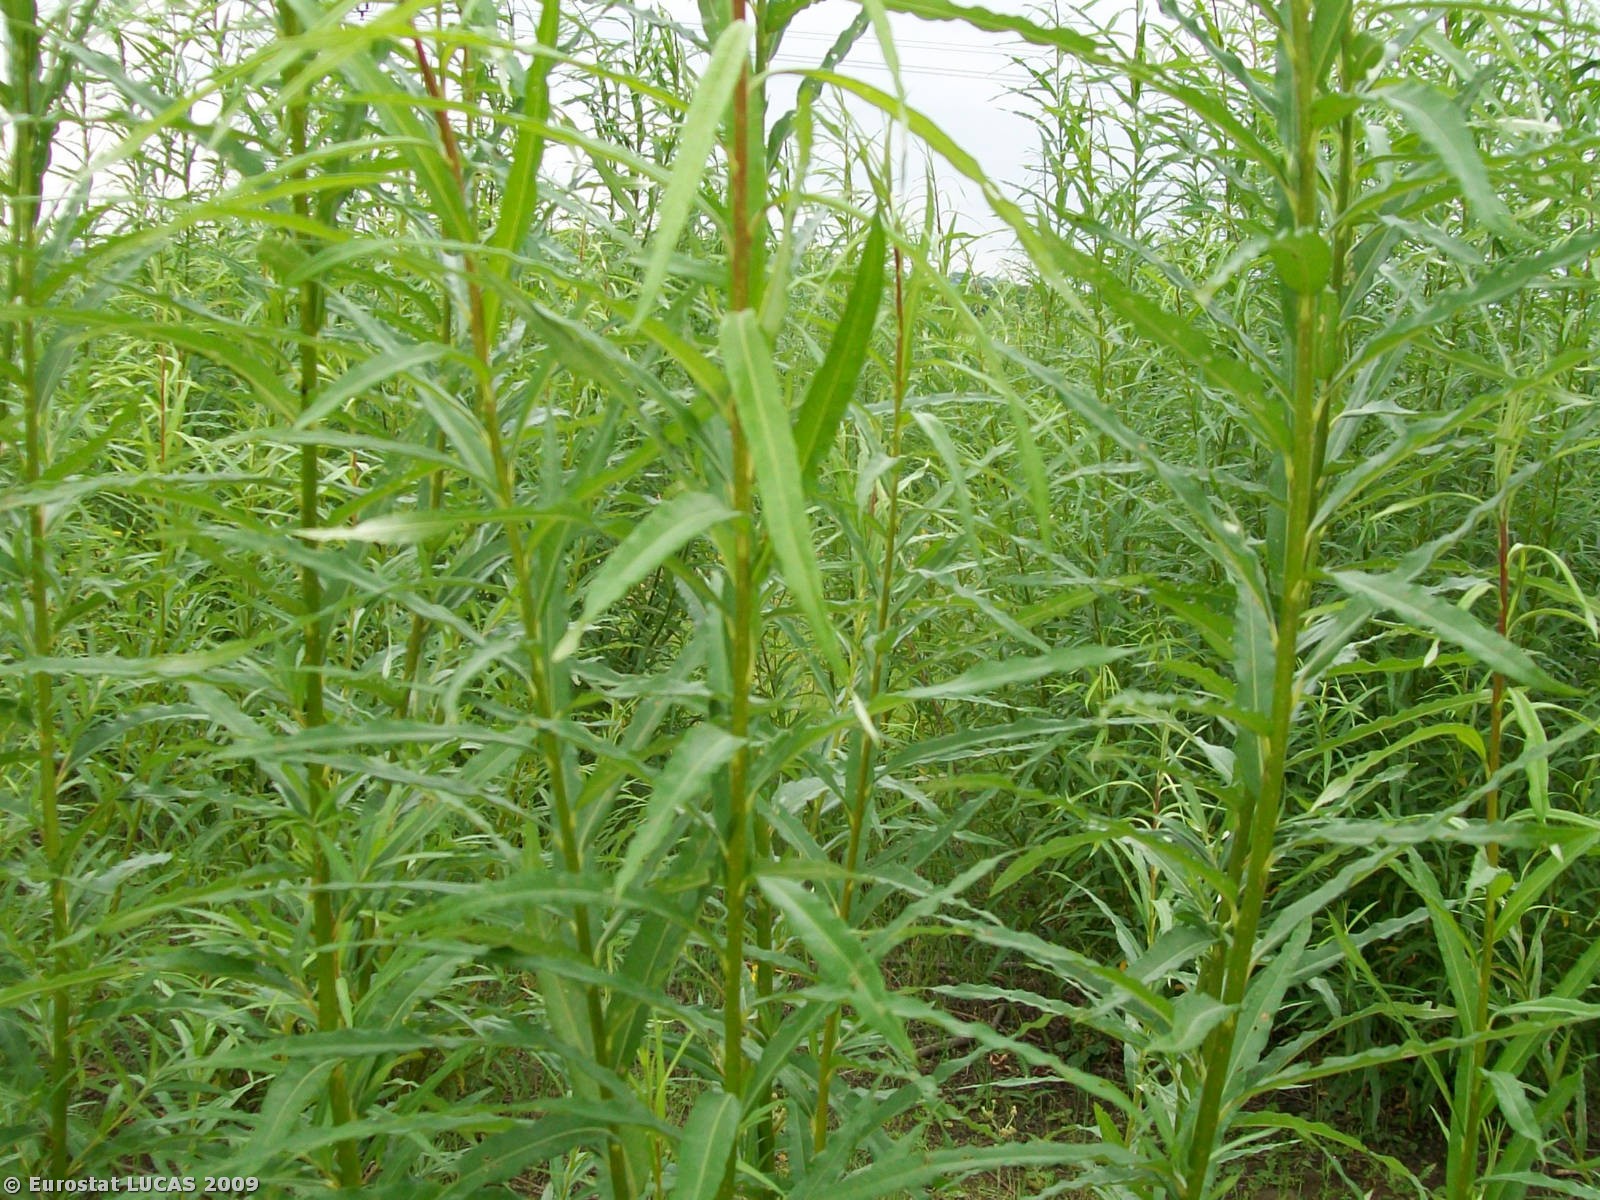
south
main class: Woodland
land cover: Broadleaved woodland
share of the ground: 50 - 75 %
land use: Energy production
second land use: Forestry
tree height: > 5 m
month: July
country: GB
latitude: 53.7361
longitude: -1.3724
